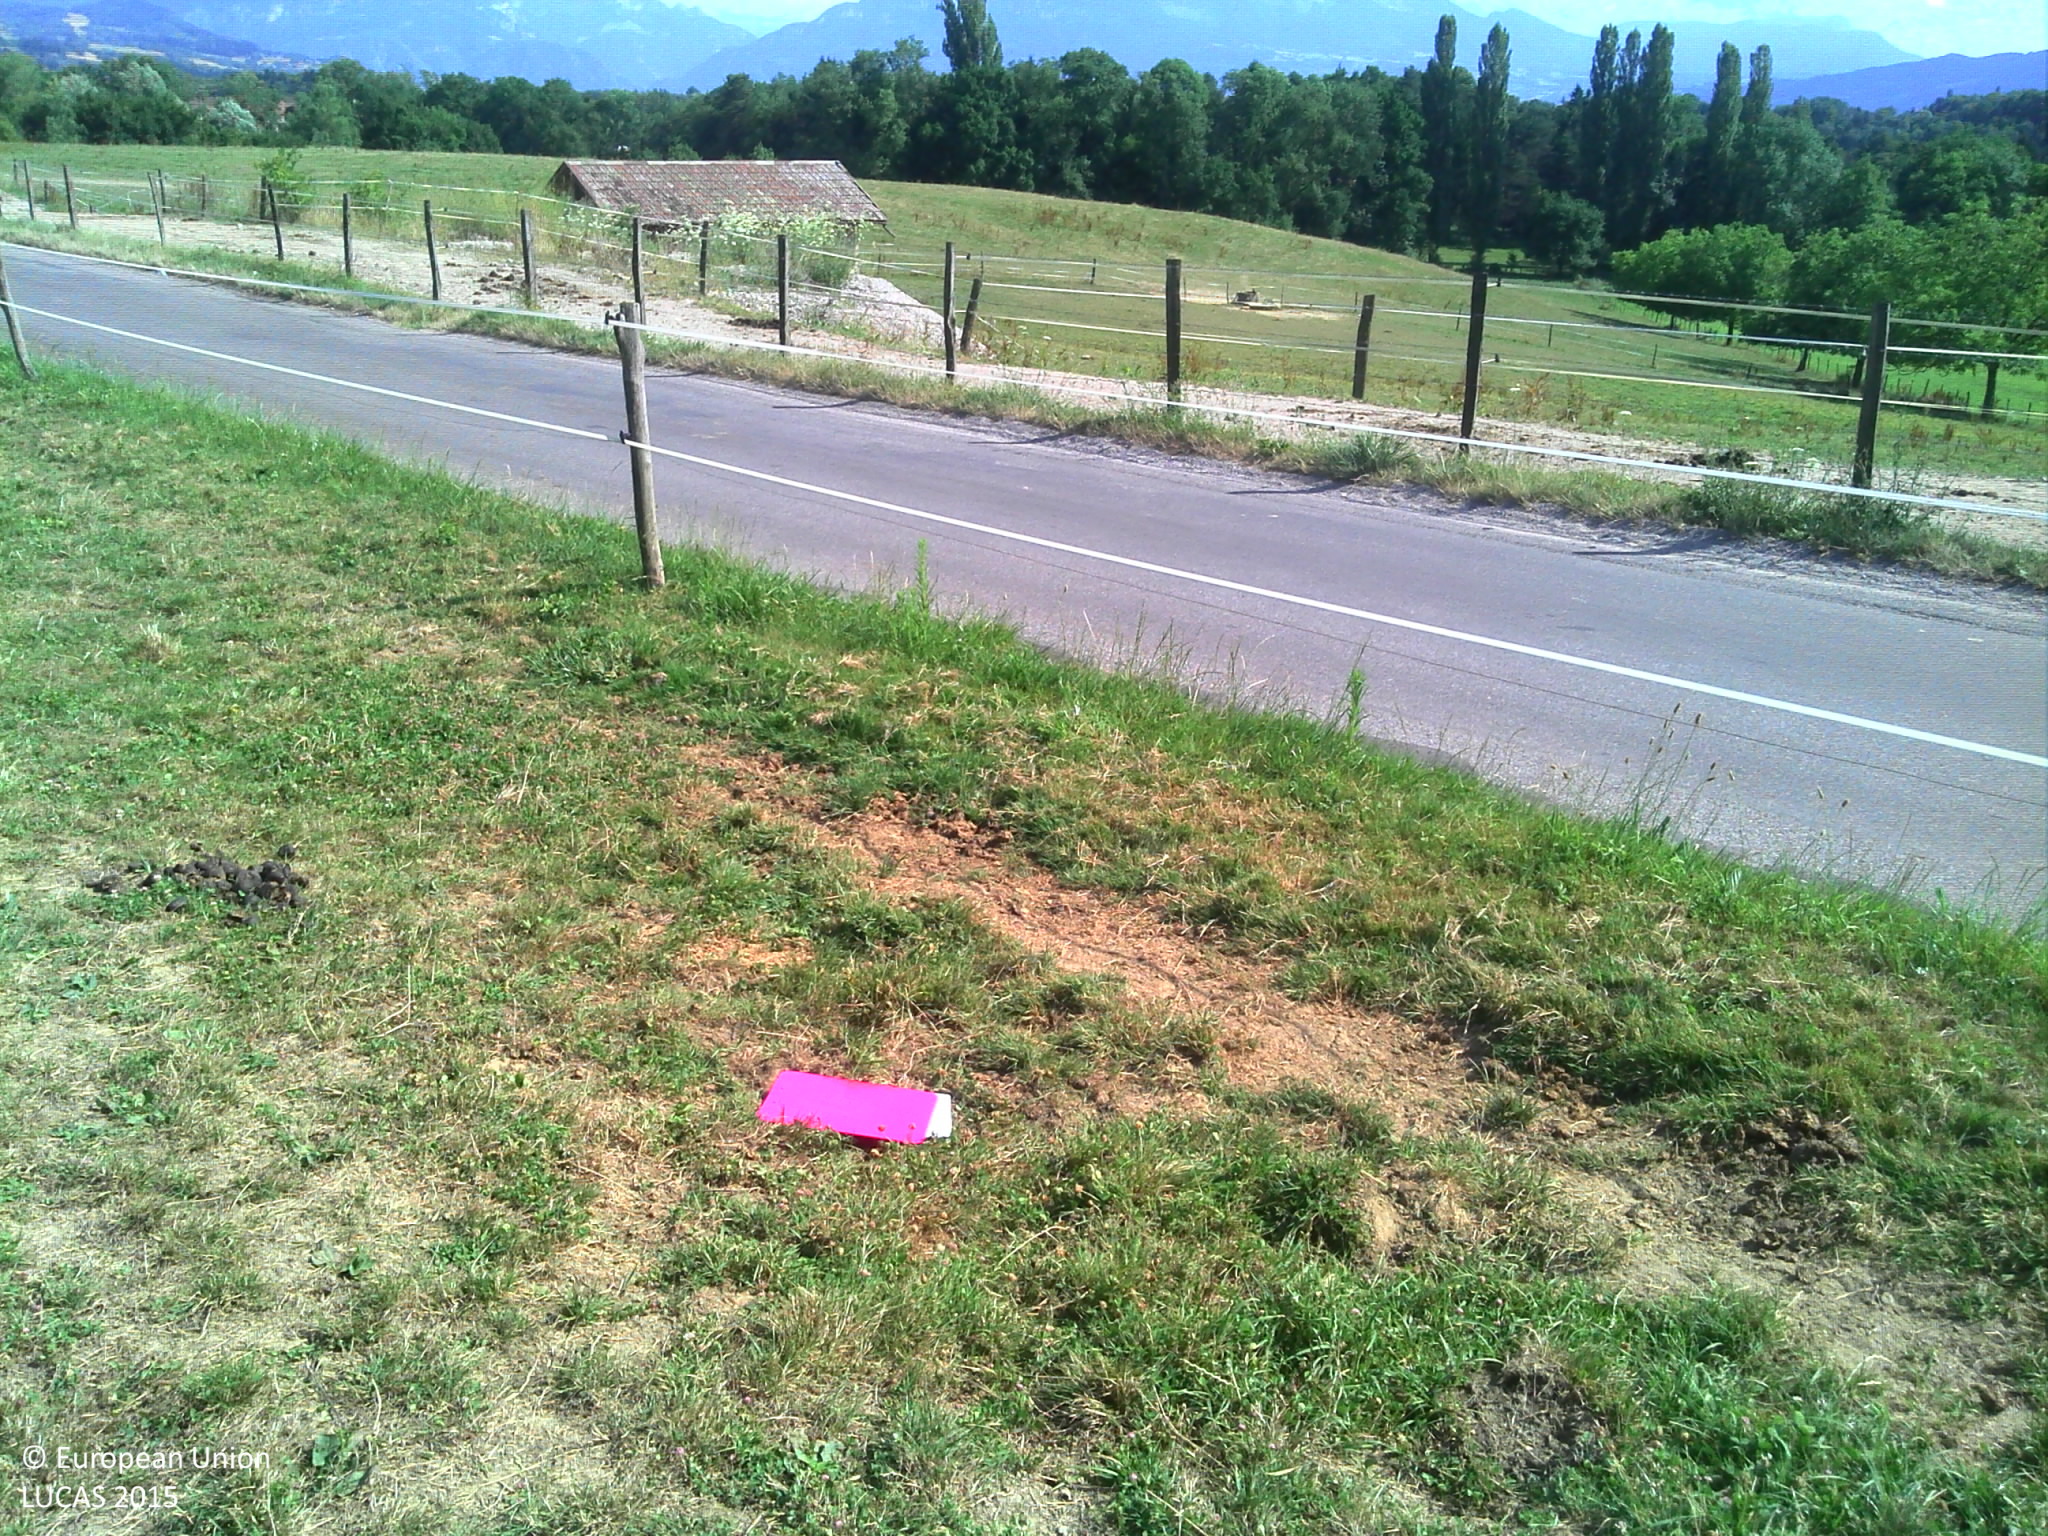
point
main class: Grassland
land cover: Grassland without tree/shrub cover
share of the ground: > 75 %
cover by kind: herbaceous plants 100 %
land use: Agriculture (excluding fallow land and kitchen gardens)
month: July
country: FR
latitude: 46.1795
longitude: 6.3115
